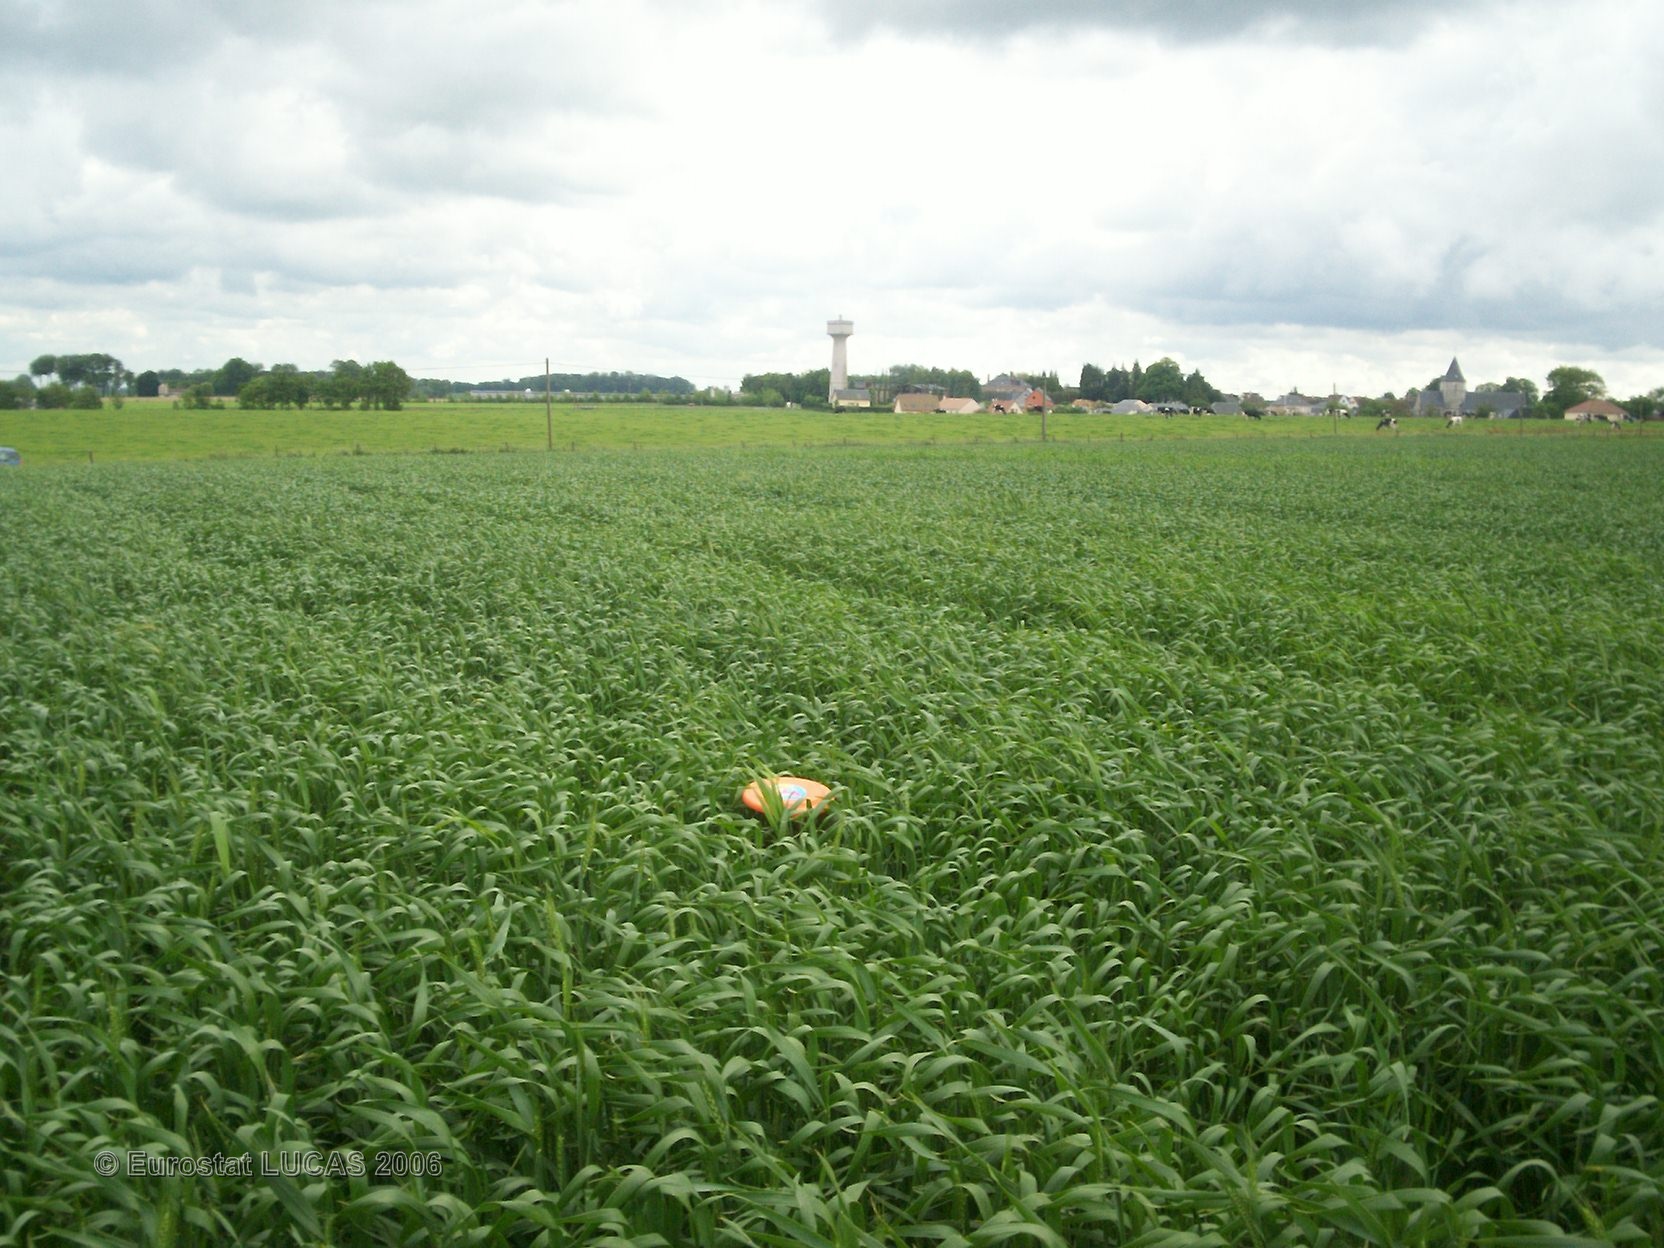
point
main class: Cropland
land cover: Common wheat
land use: Agriculture (excluding fallow land and kitchen gardens)
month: May
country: FR
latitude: 49.6338
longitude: 0.4048
